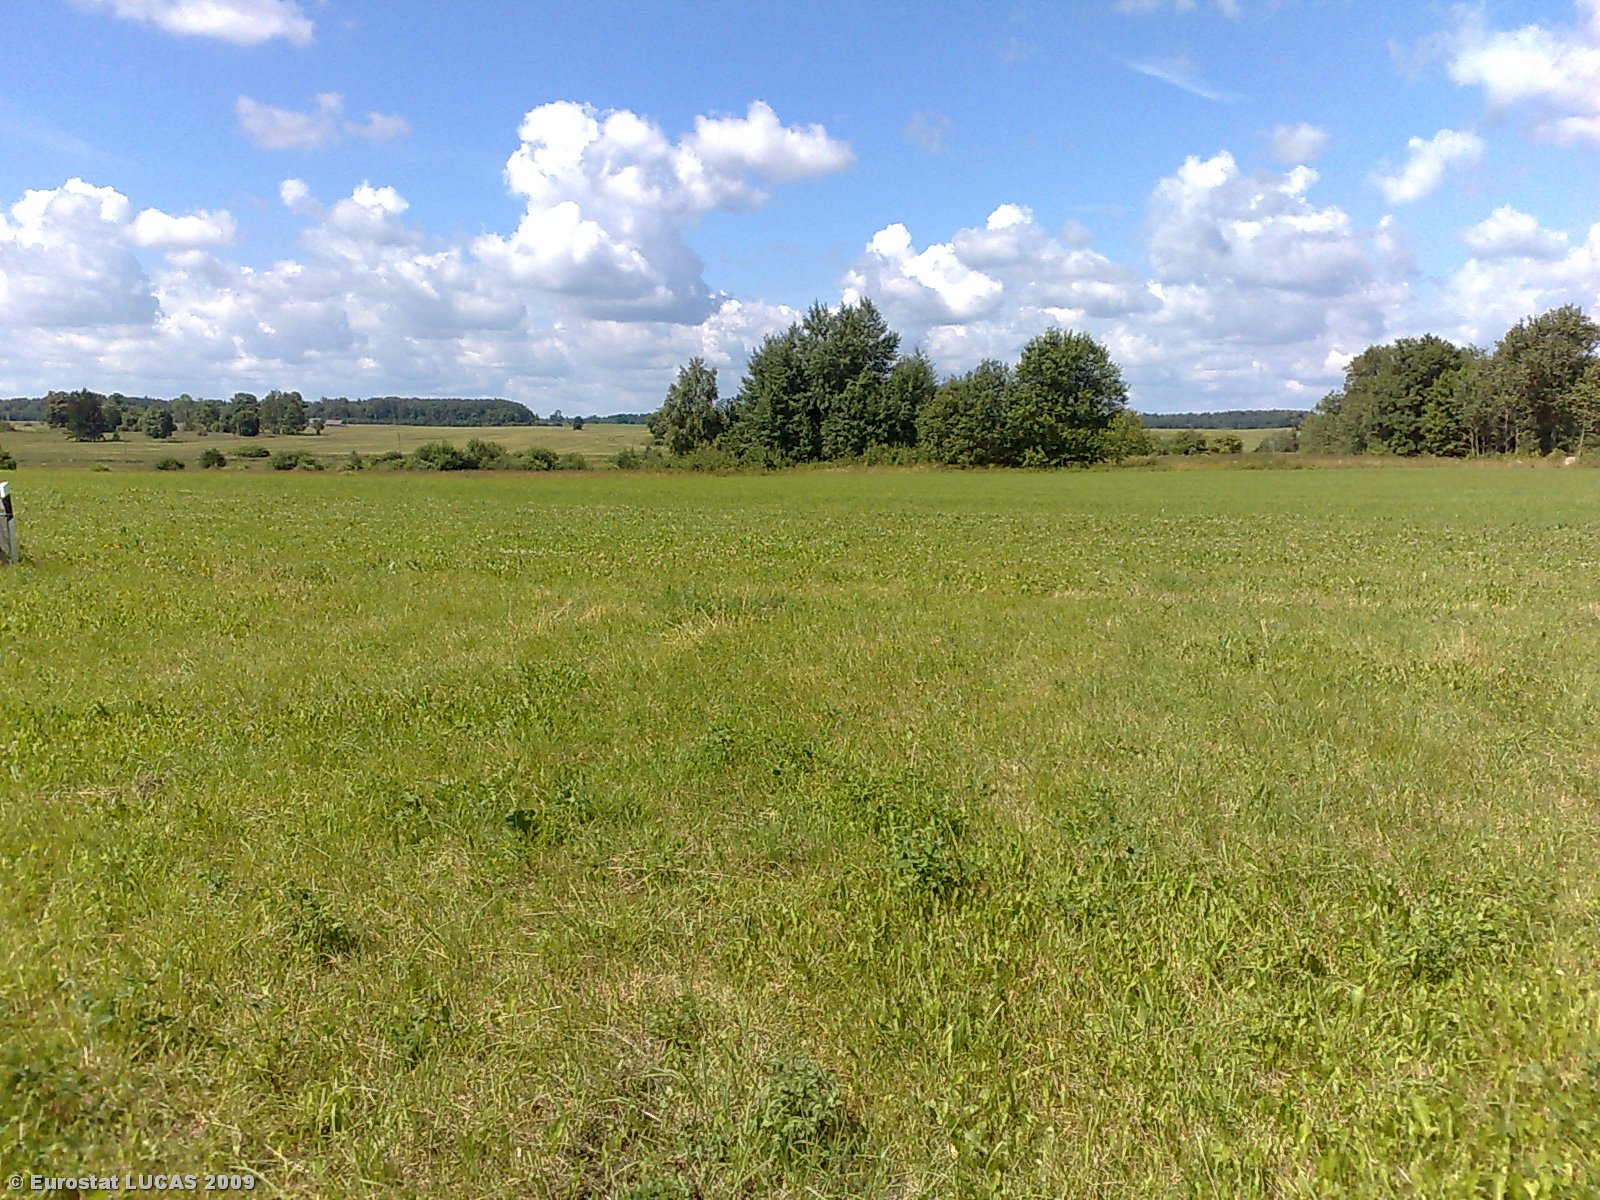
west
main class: Grassland
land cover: Grassland without tree/shrub cover
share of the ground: > 75 %
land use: Agriculture (excluding fallow land and kitchen gardens)
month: July
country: LT
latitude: 55.9354
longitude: 22.8885
